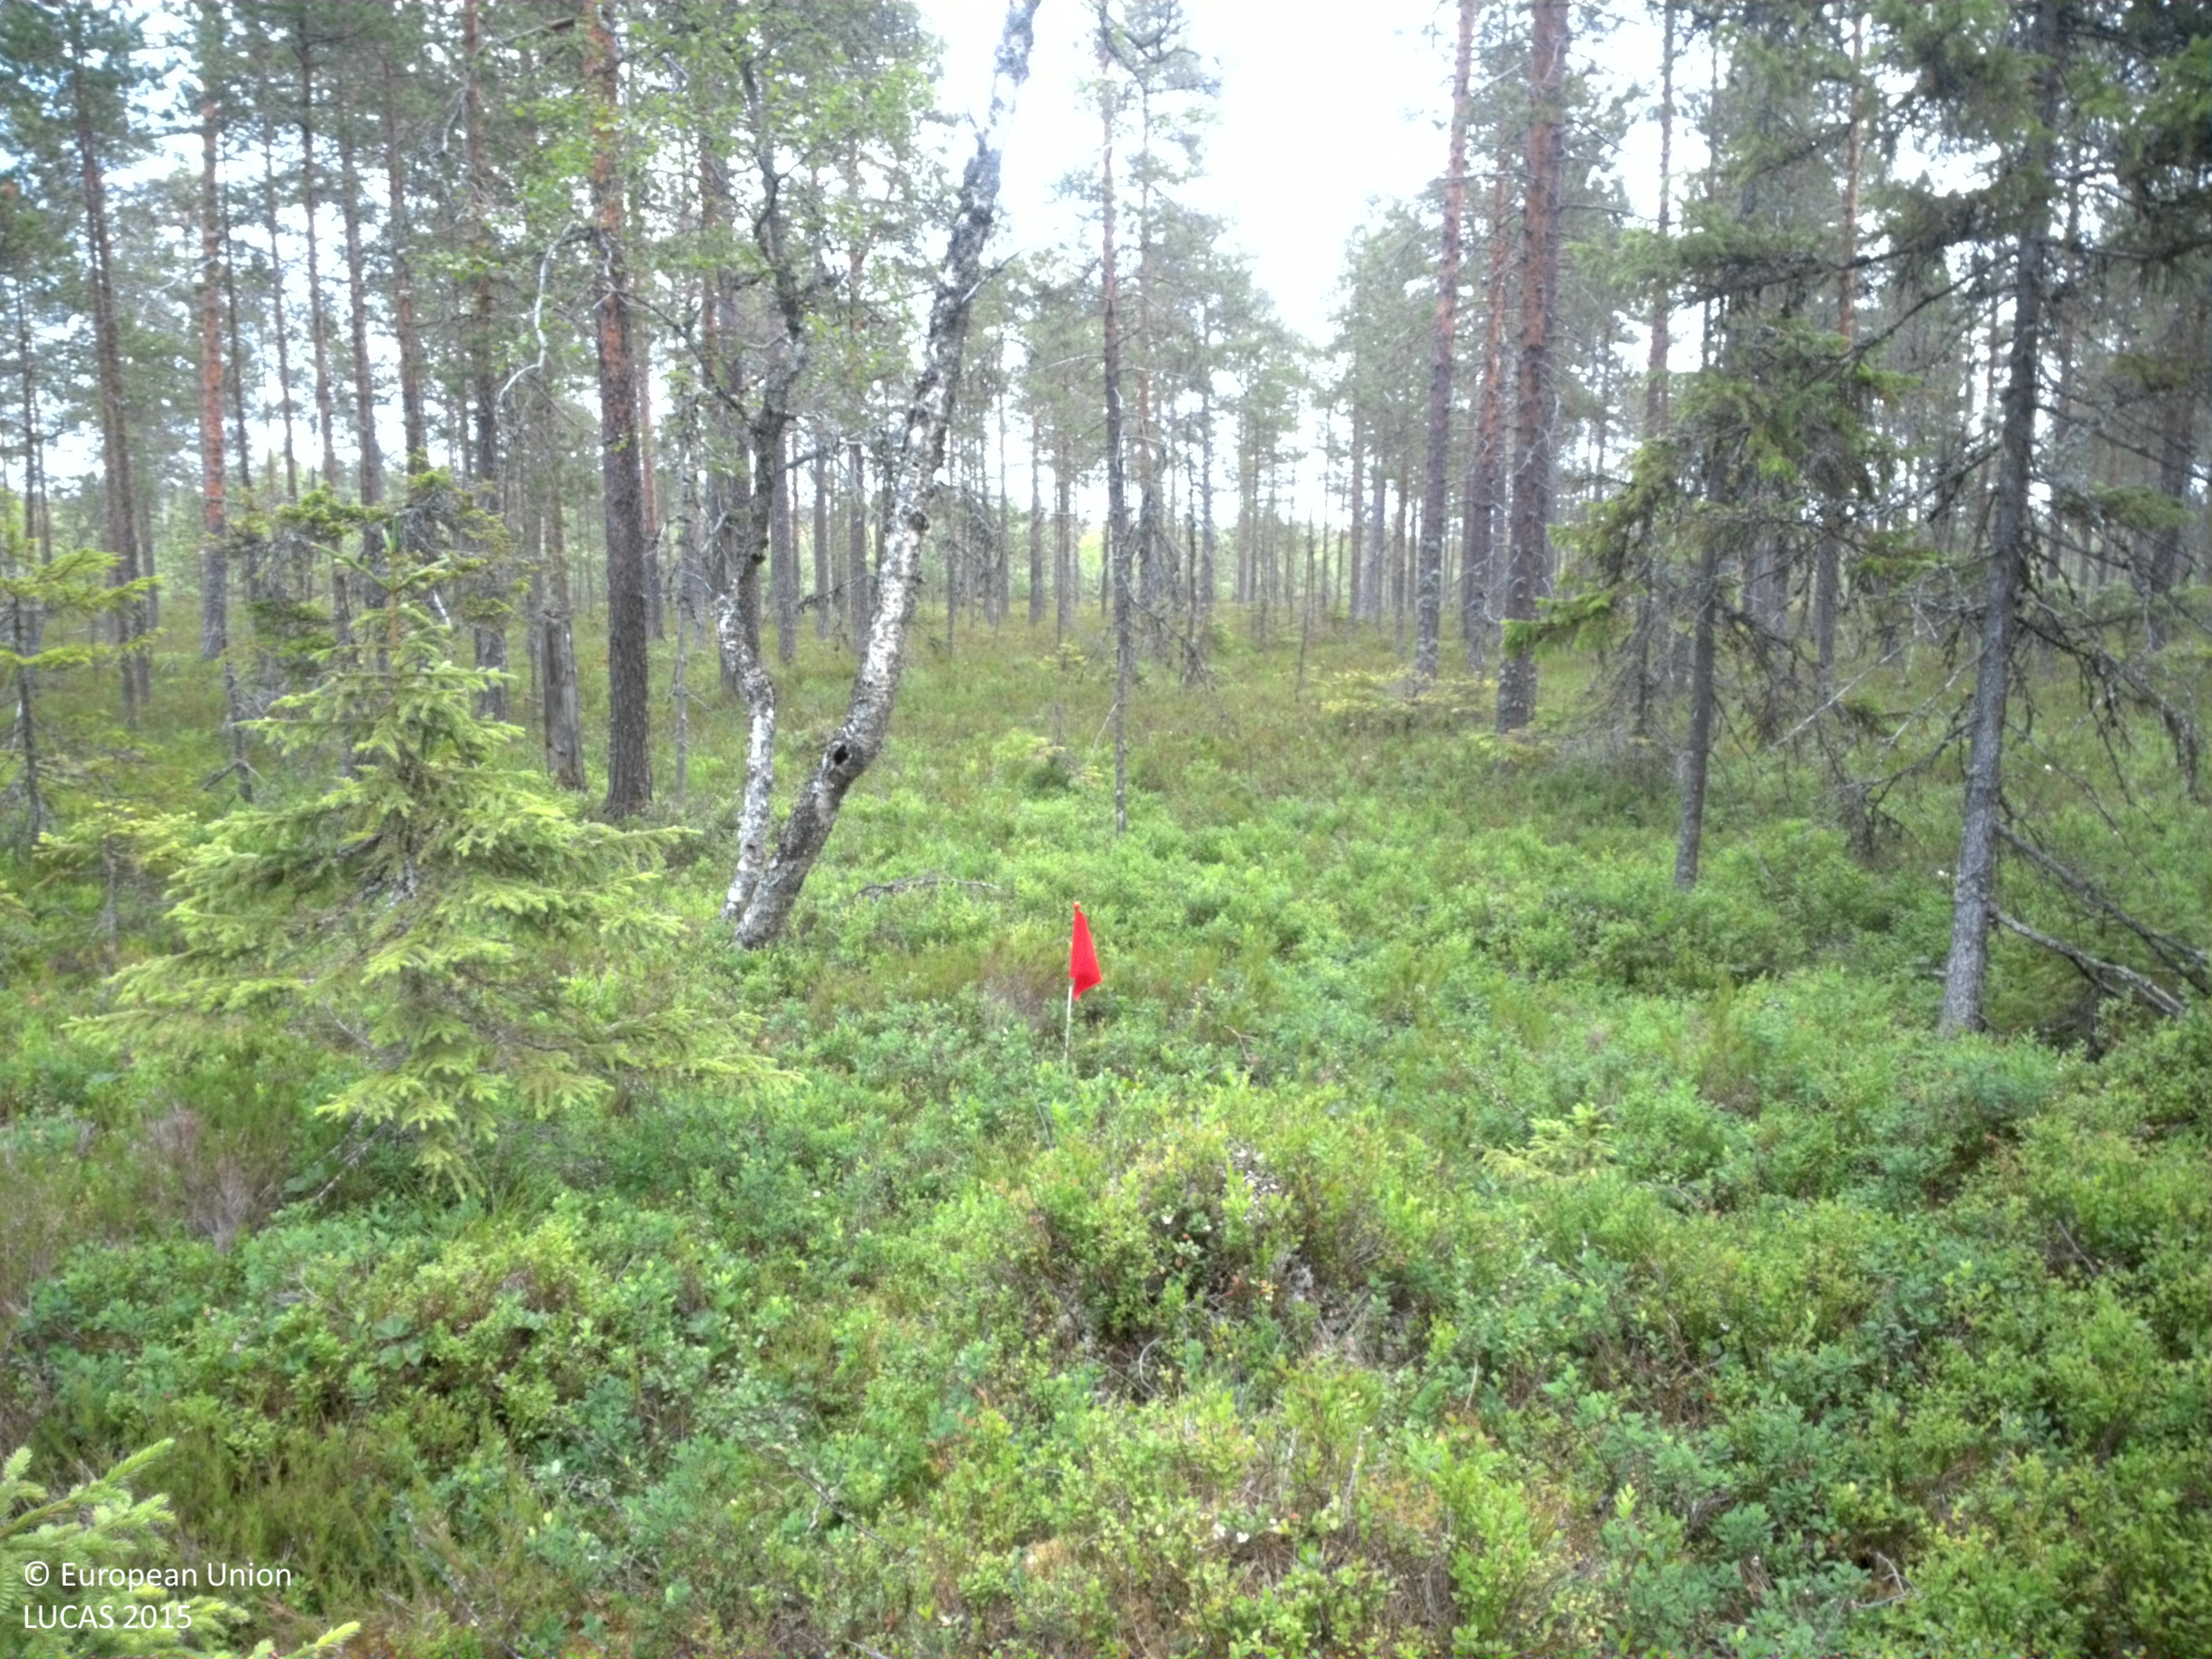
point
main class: Woodland
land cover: Pine dominated coniferous woodland
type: mire and swamp forests
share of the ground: 25 - 50 %
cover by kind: coniferous forest trees 50 %, shrubs 50 %
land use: Forestry
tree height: > 5 m
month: July
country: SE
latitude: 64.3816
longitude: 21.2399
